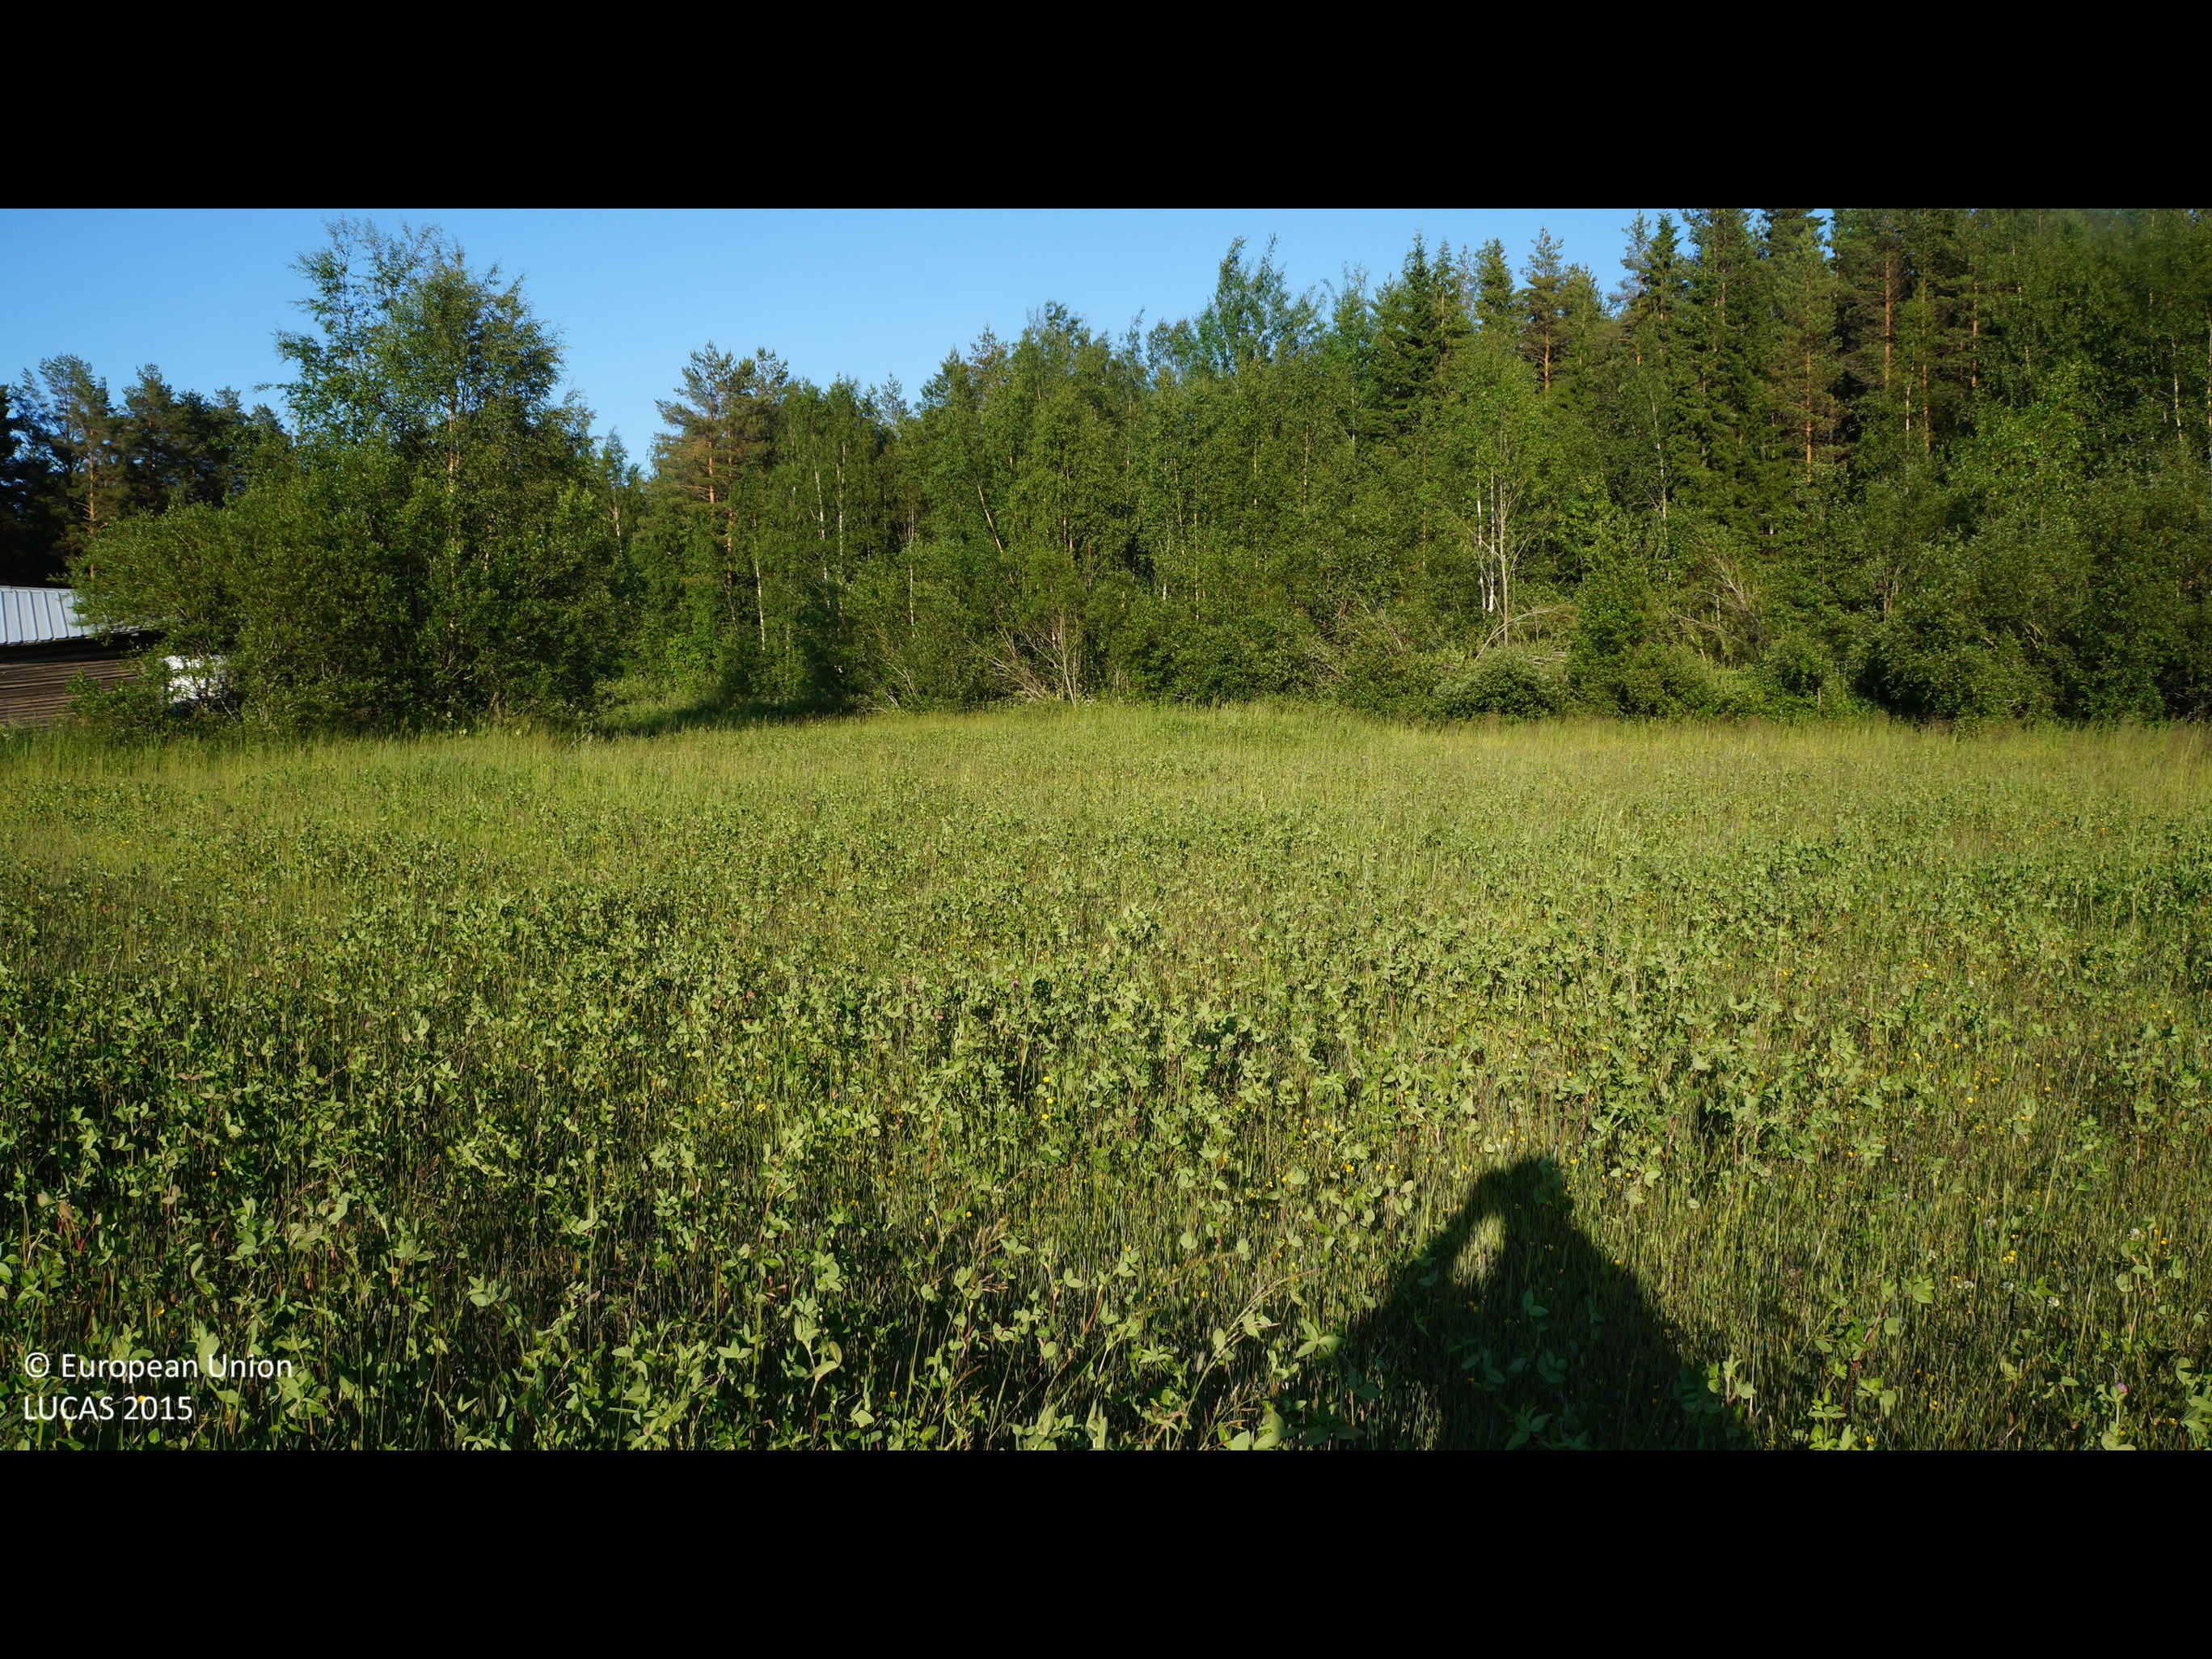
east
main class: Cropland
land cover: Other leguminous and mixtures for fodder
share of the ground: > 75 %
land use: Agriculture (excluding fallow land and kitchen gardens)
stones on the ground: < 10 %
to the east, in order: Other leguminous and mixtures for fodder; Ditches and canals; Shrubland with sparse tree cover; Ditches and canals; Other leguminous and mixtures for fodder; Ditches and canals; Other leguminous and mixtures for fodder; Rivers and streams; Other mixed woodland; Ditches and canals; Grass margins; Paved roads, cycling and walking lanes; Grass margins; Ditches and canals; Electric lines; Temporary grasslands; Ditches and canals; Temporary grasslands; Ditches and canals; Temporary grasslands
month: July
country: FI
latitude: 63.6655
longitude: 22.9219
